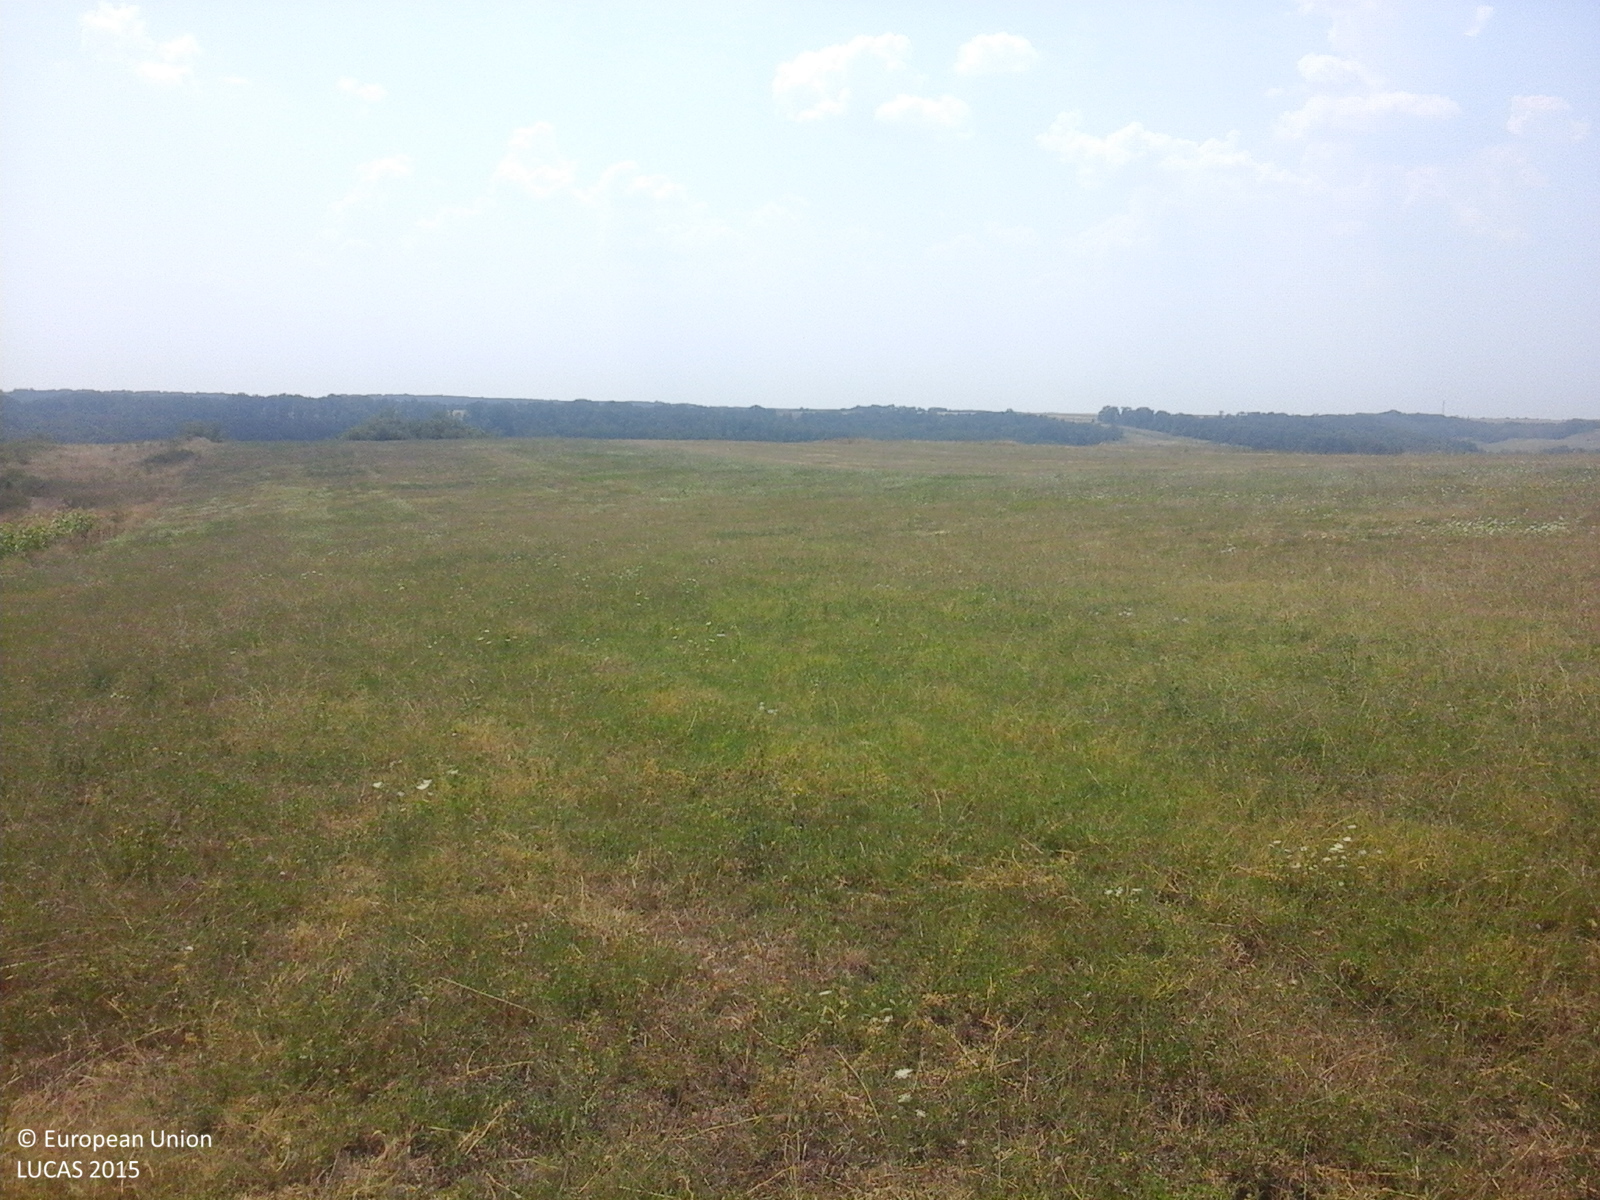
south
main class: Grassland
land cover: Grassland without tree/shrub cover
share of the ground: > 75 %
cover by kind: herbaceous plants 100 %
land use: Agriculture (excluding fallow land and kitchen gardens)
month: August
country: RO
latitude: 44.5112
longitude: 23.1684
